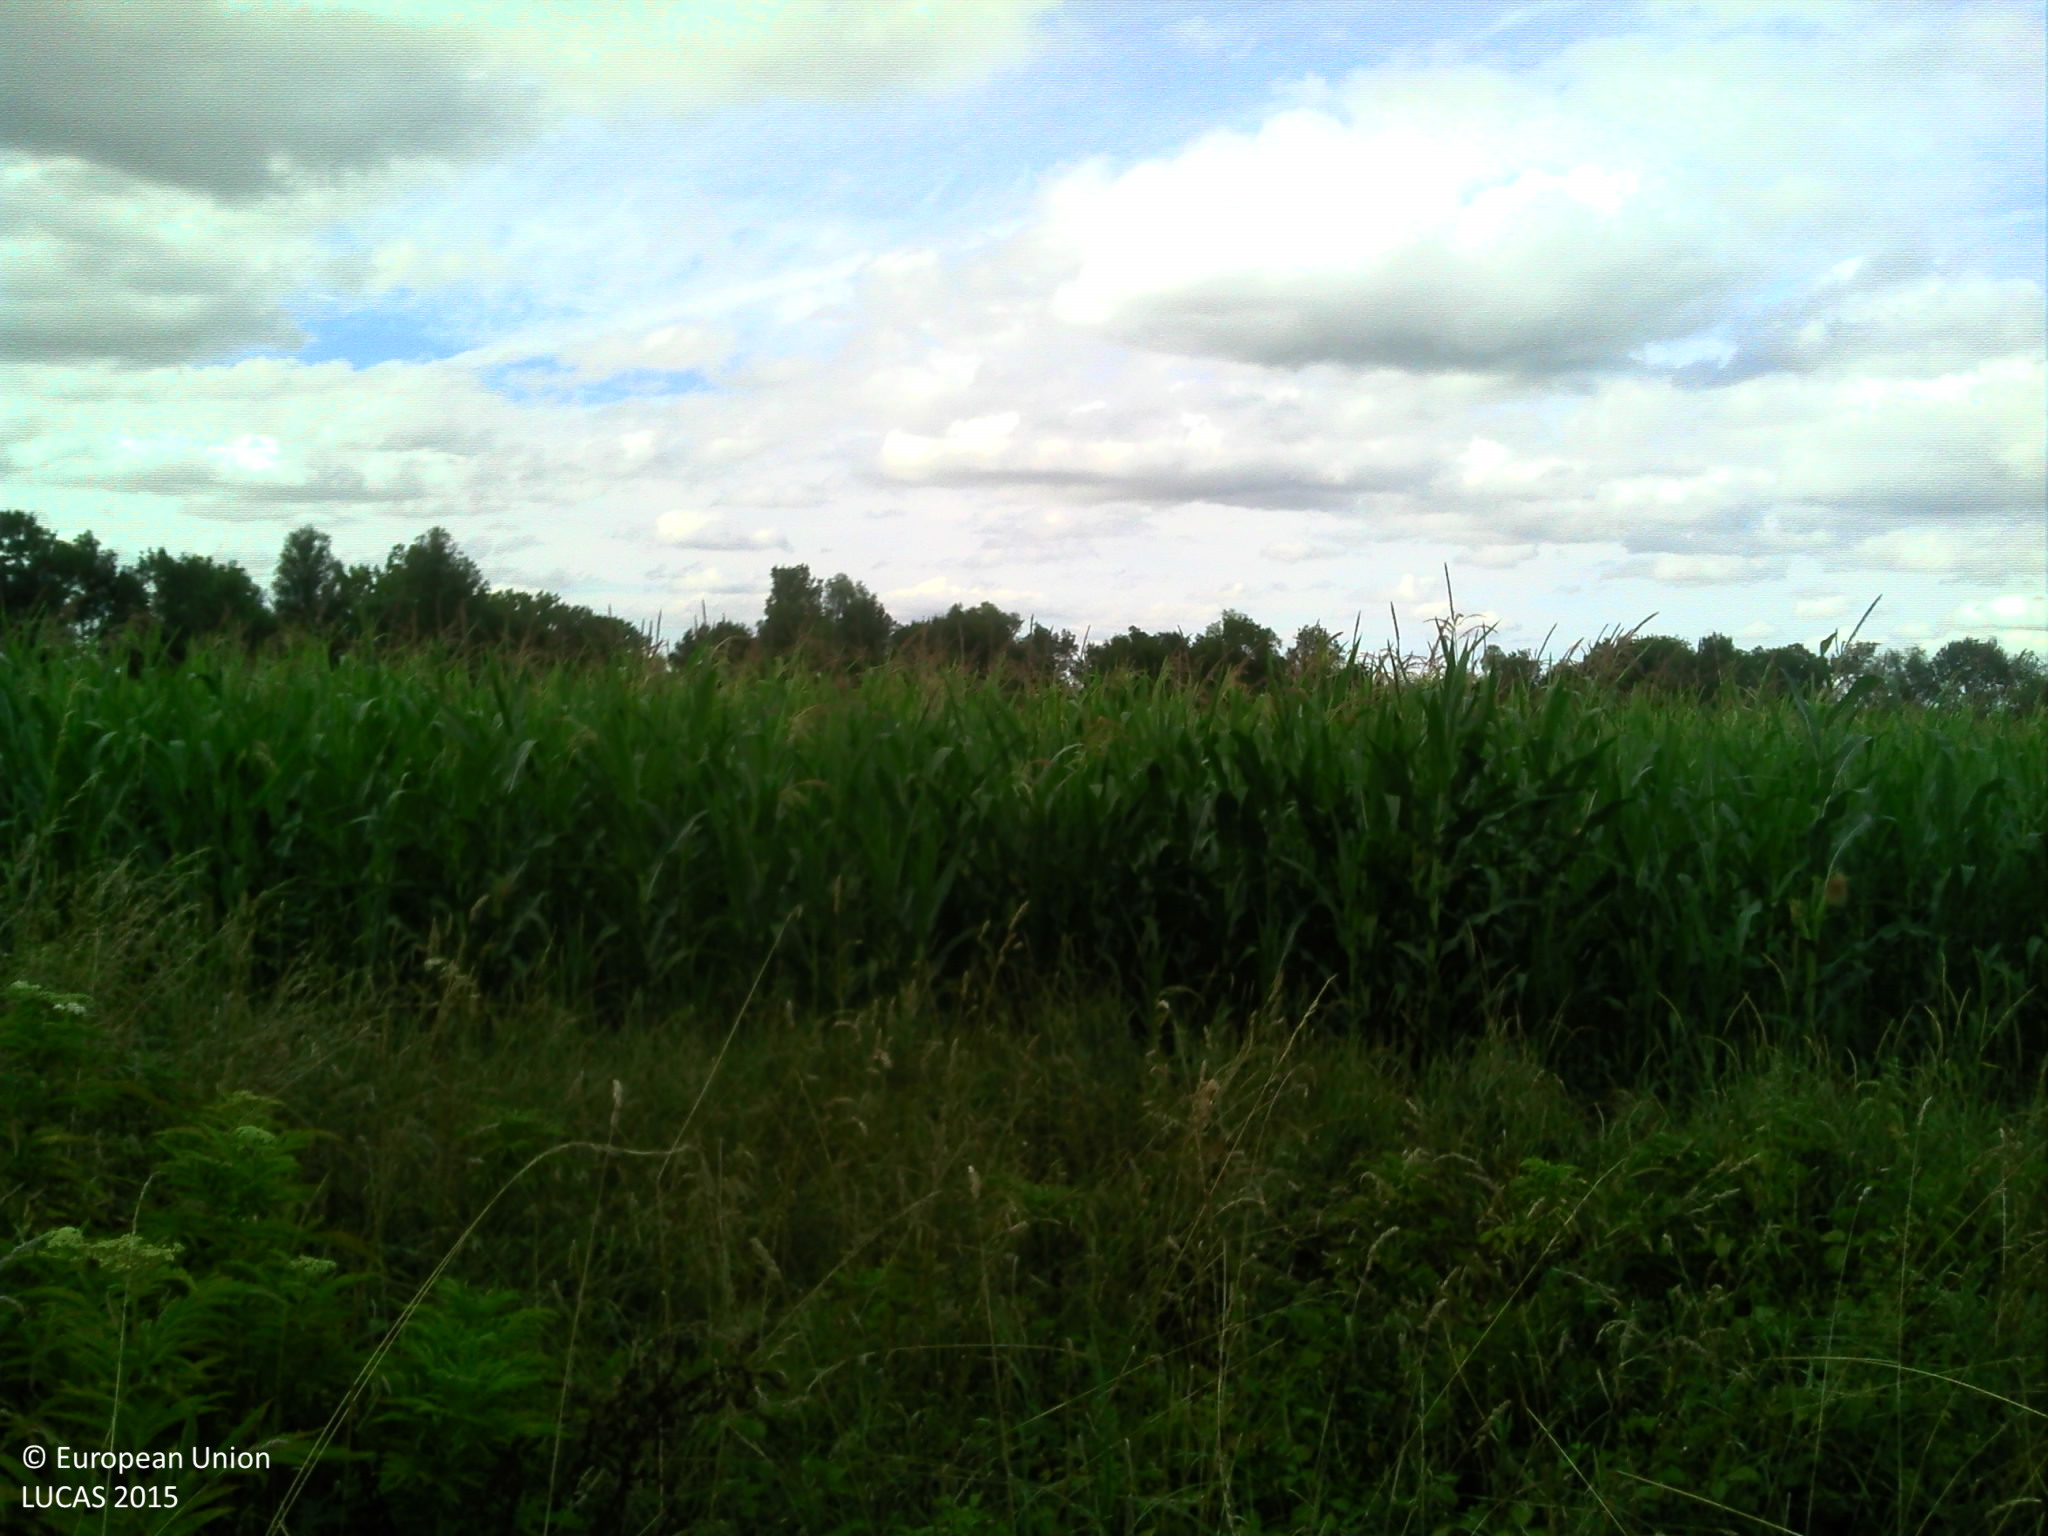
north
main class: Grassland
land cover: Spontaneously vegetated surfaces
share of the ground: > 75 %
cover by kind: herbaceous plants 100 %
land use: Agriculture (excluding fallow land and kitchen gardens)
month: July
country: FR
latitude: 46.7006
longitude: 4.9403
